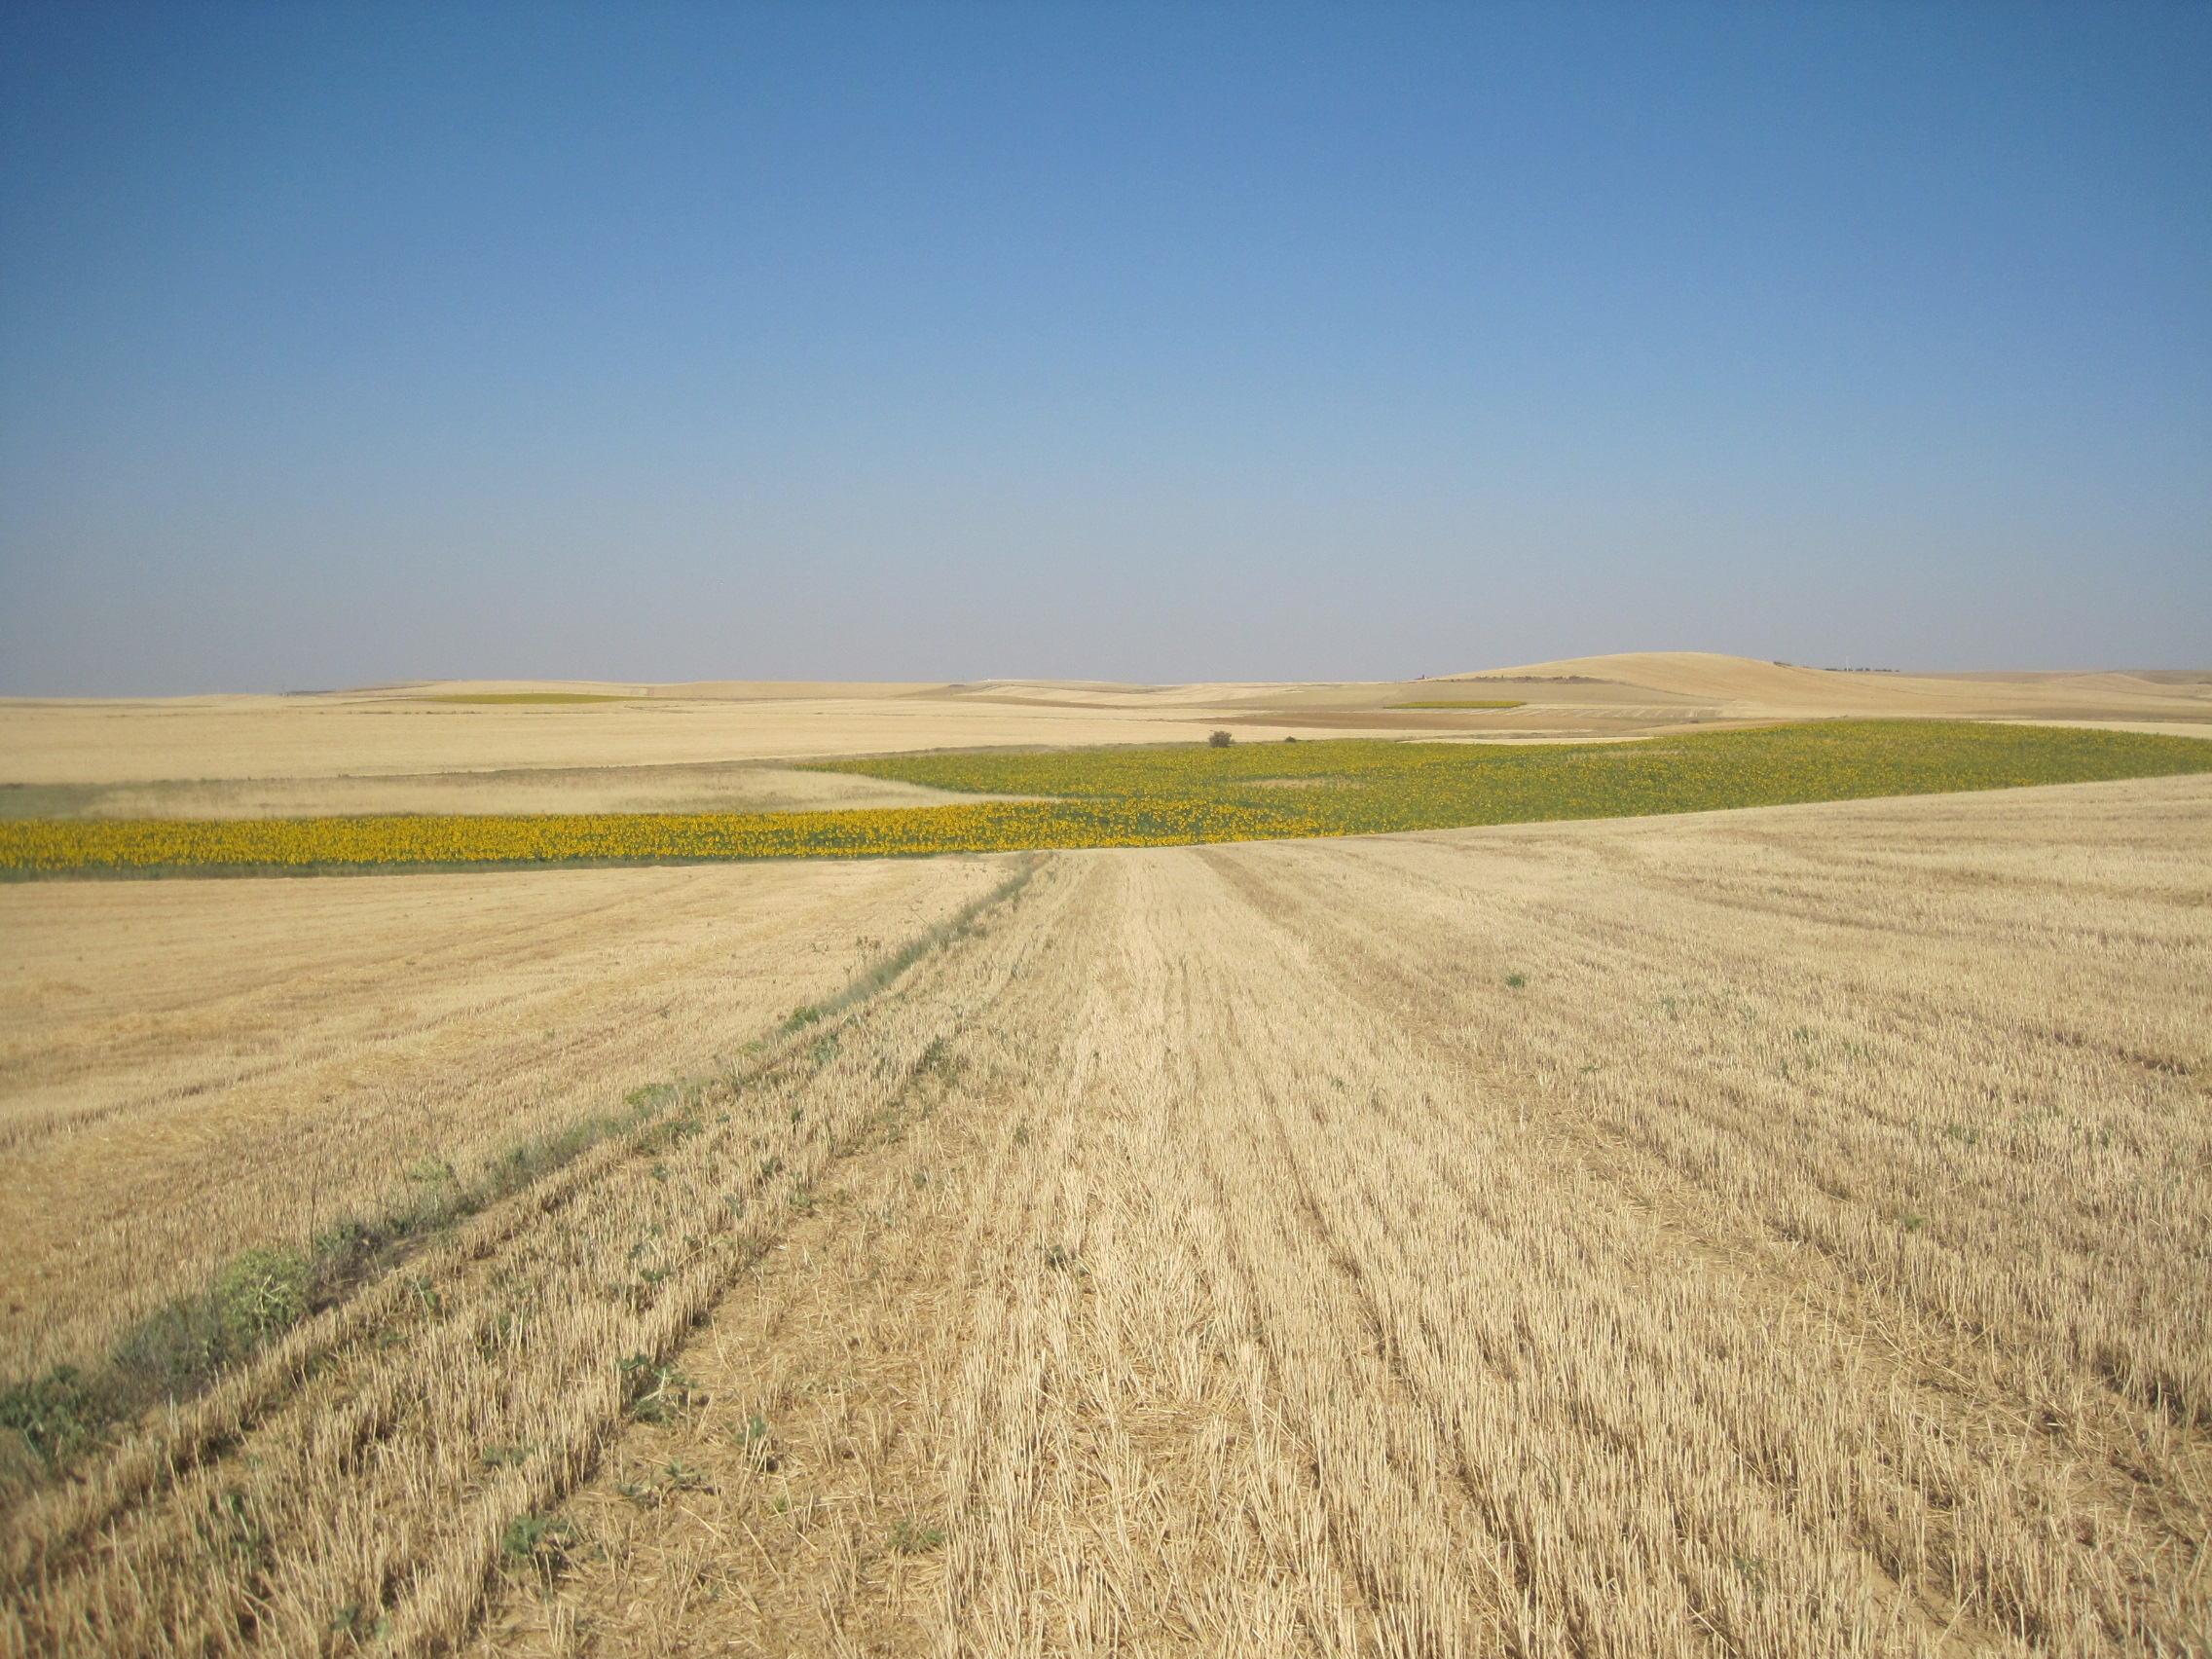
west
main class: Cropland
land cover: Barley
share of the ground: < 10 %
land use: Agriculture (excluding fallow land and kitchen gardens)
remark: Harvested field
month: July
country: ES
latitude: 41.6427
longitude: -5.3397
